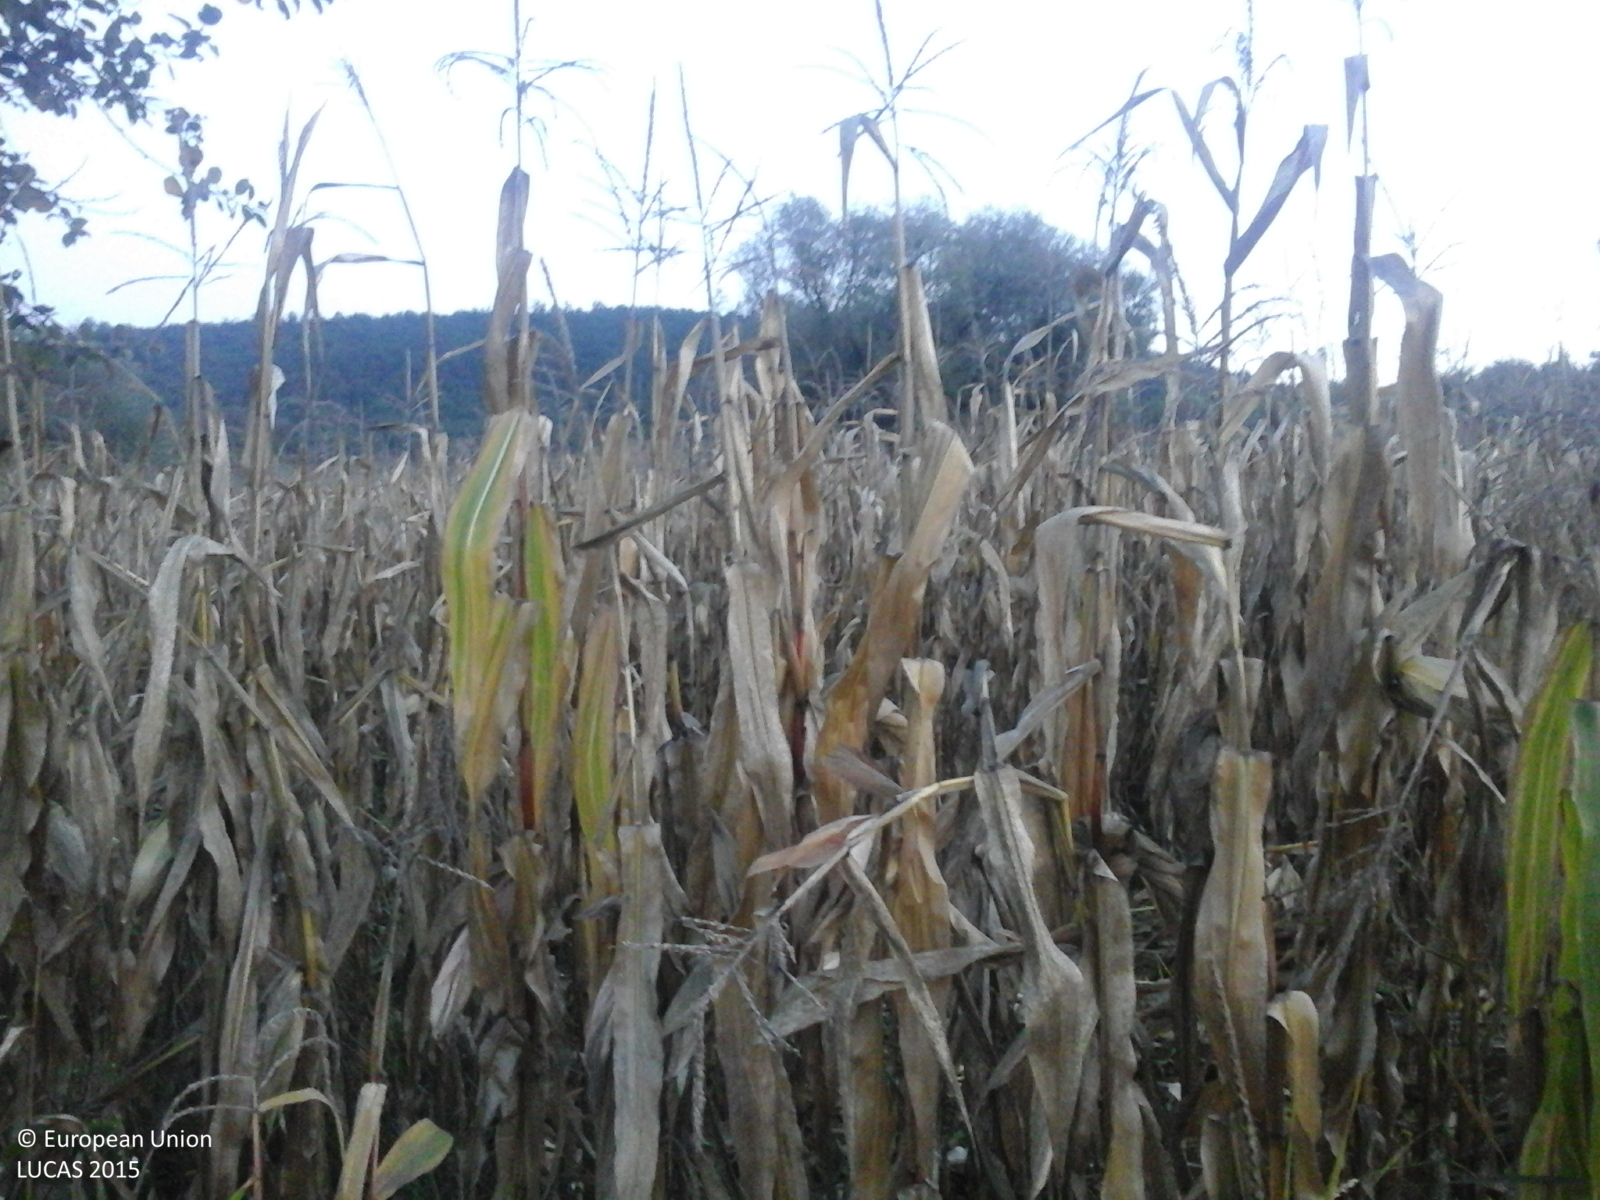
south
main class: Grassland
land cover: Spontaneously vegetated surfaces
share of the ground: > 75 %
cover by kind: herbaceous plants 100 %
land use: Fallow land
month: October
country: RO
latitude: 46.0023
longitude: 24.1910
